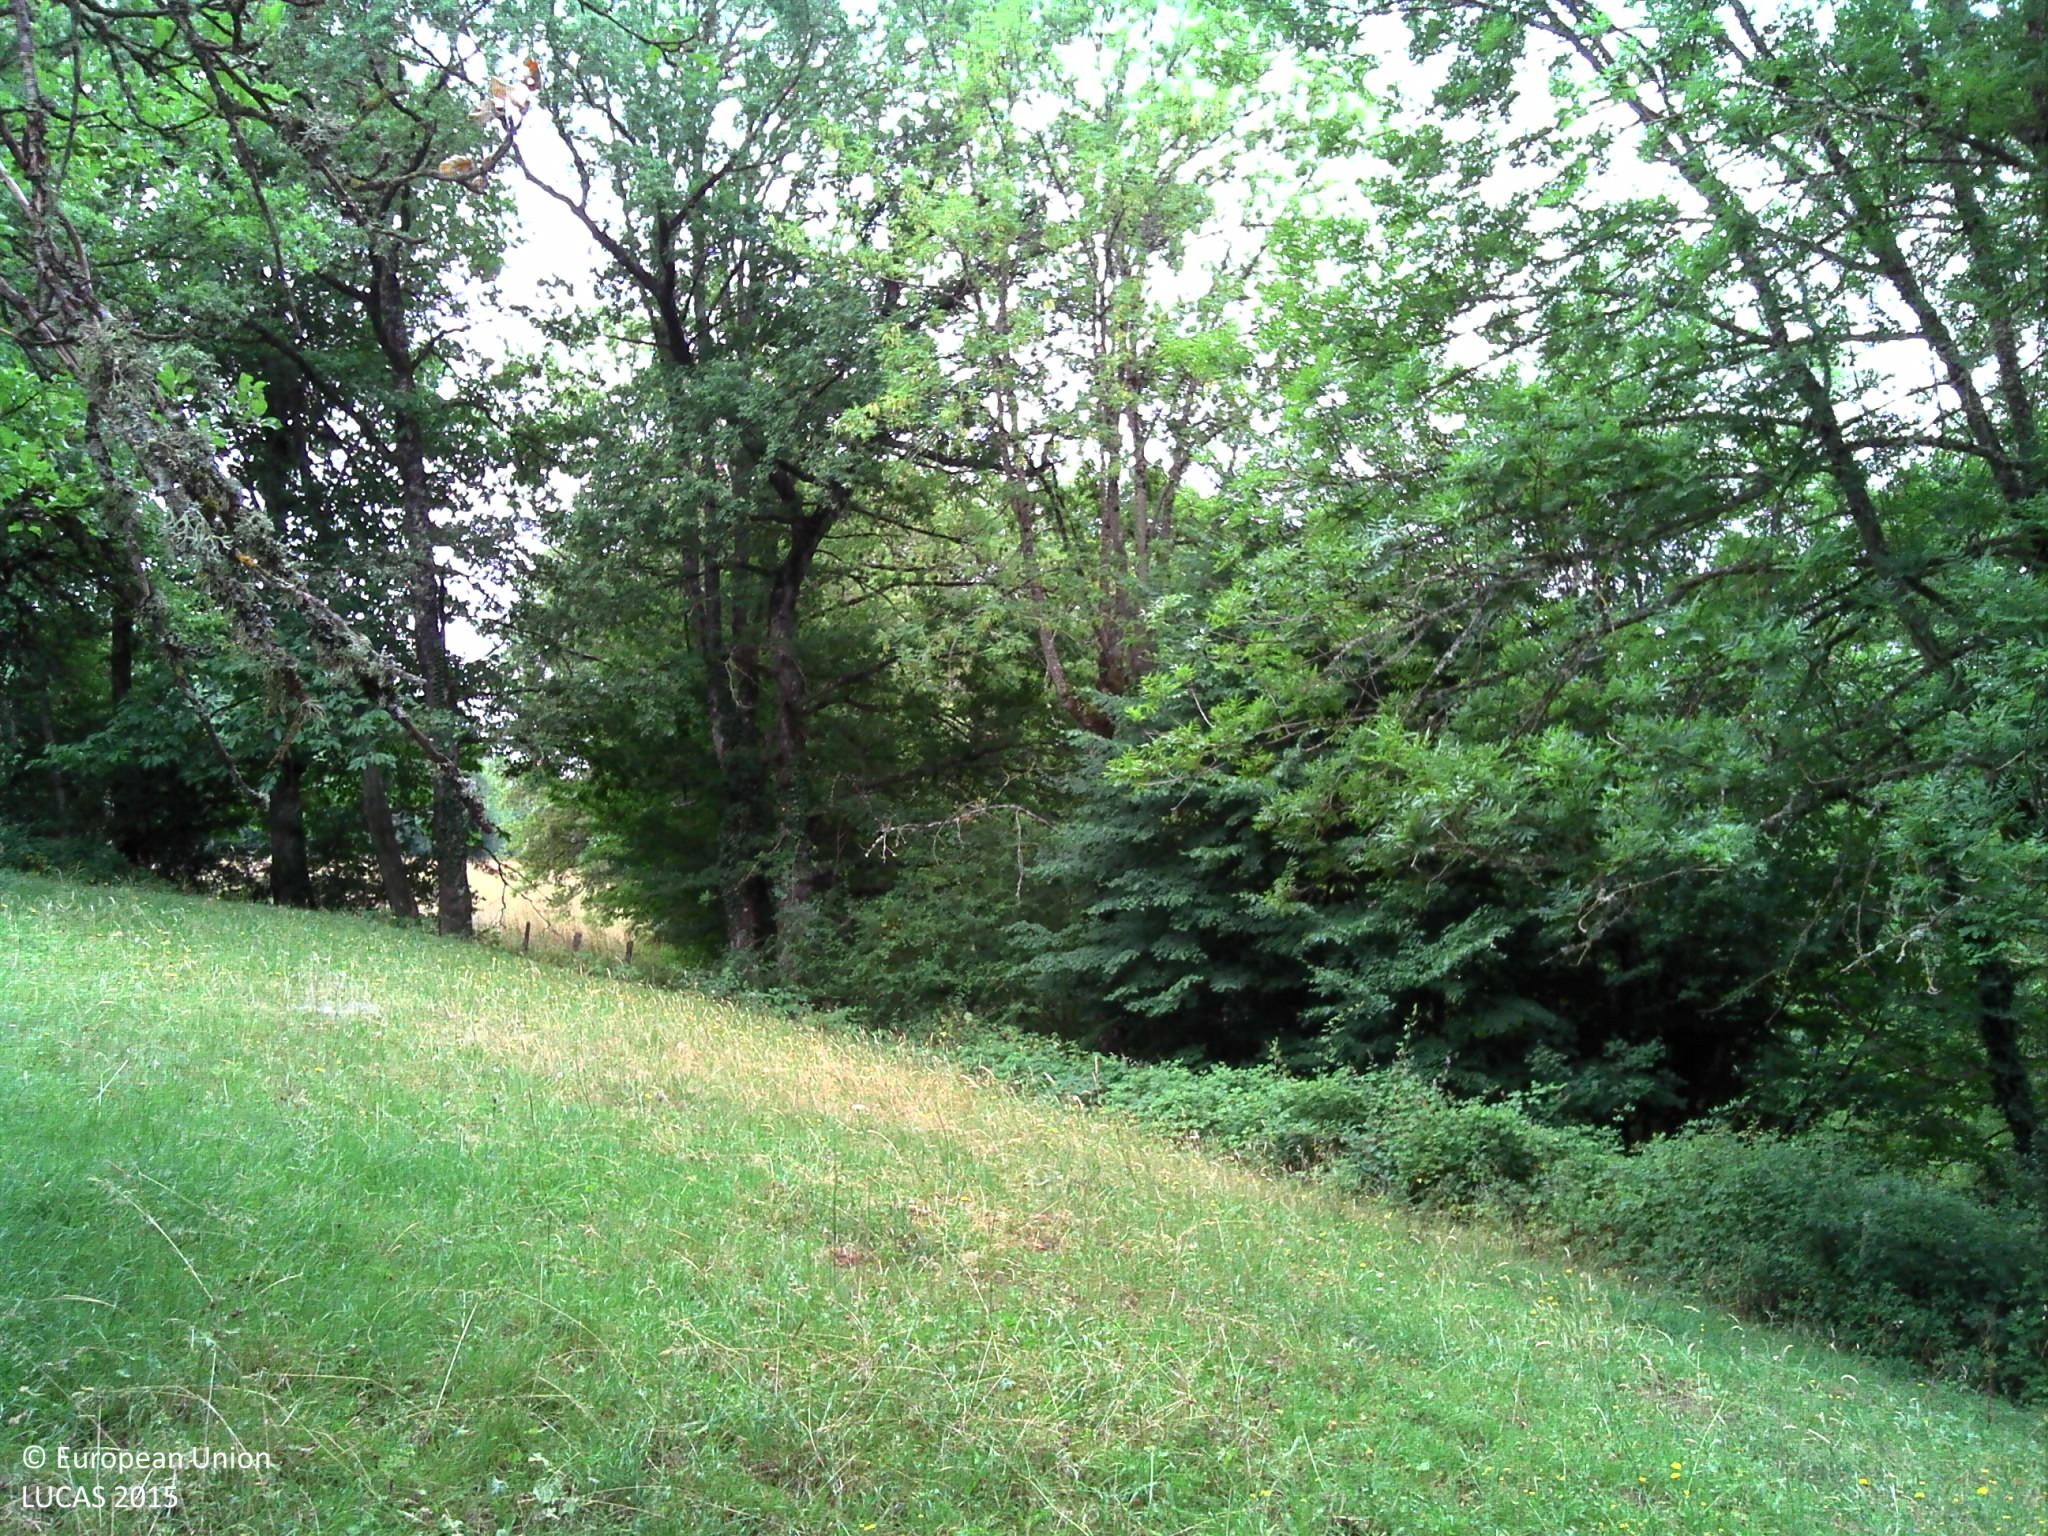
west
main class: Woodland
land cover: Broadleaved woodland
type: mesophytic deciduous forest
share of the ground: > 75 %
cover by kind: broadleaved forest trees 85 %, shrubs 10 %, lichens and mosses 5 %
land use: Forestry
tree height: > 5 m
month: July
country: FR
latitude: 44.4436
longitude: 3.0561
